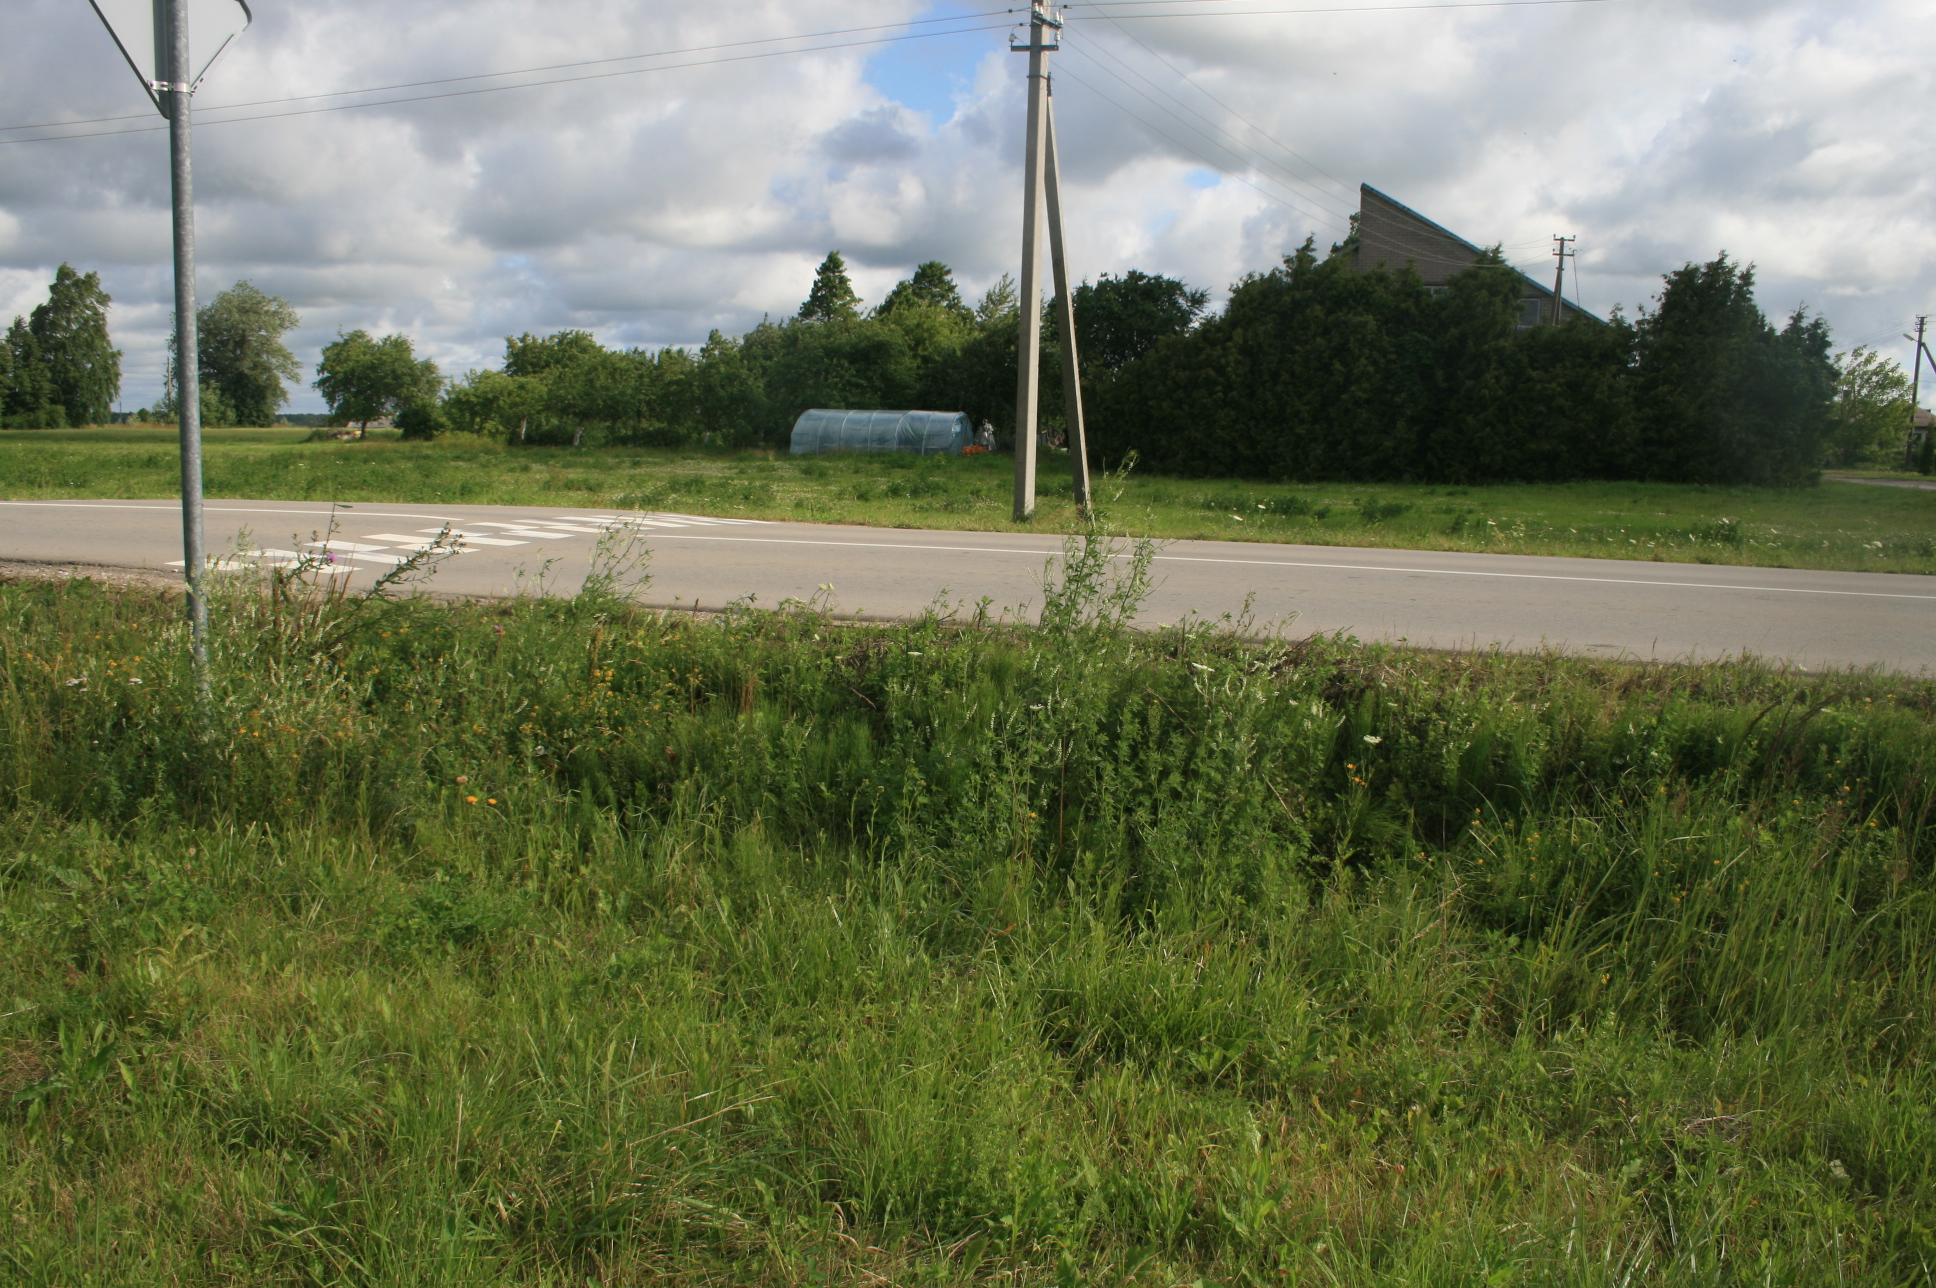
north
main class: Grassland
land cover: Grassland without tree/shrub cover
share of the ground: > 75 %
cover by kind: herbaceous plants 100 %
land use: Agriculture (excluding fallow land and kitchen gardens)
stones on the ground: < 10 %
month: July
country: LT
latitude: 55.8622
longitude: 21.3712
